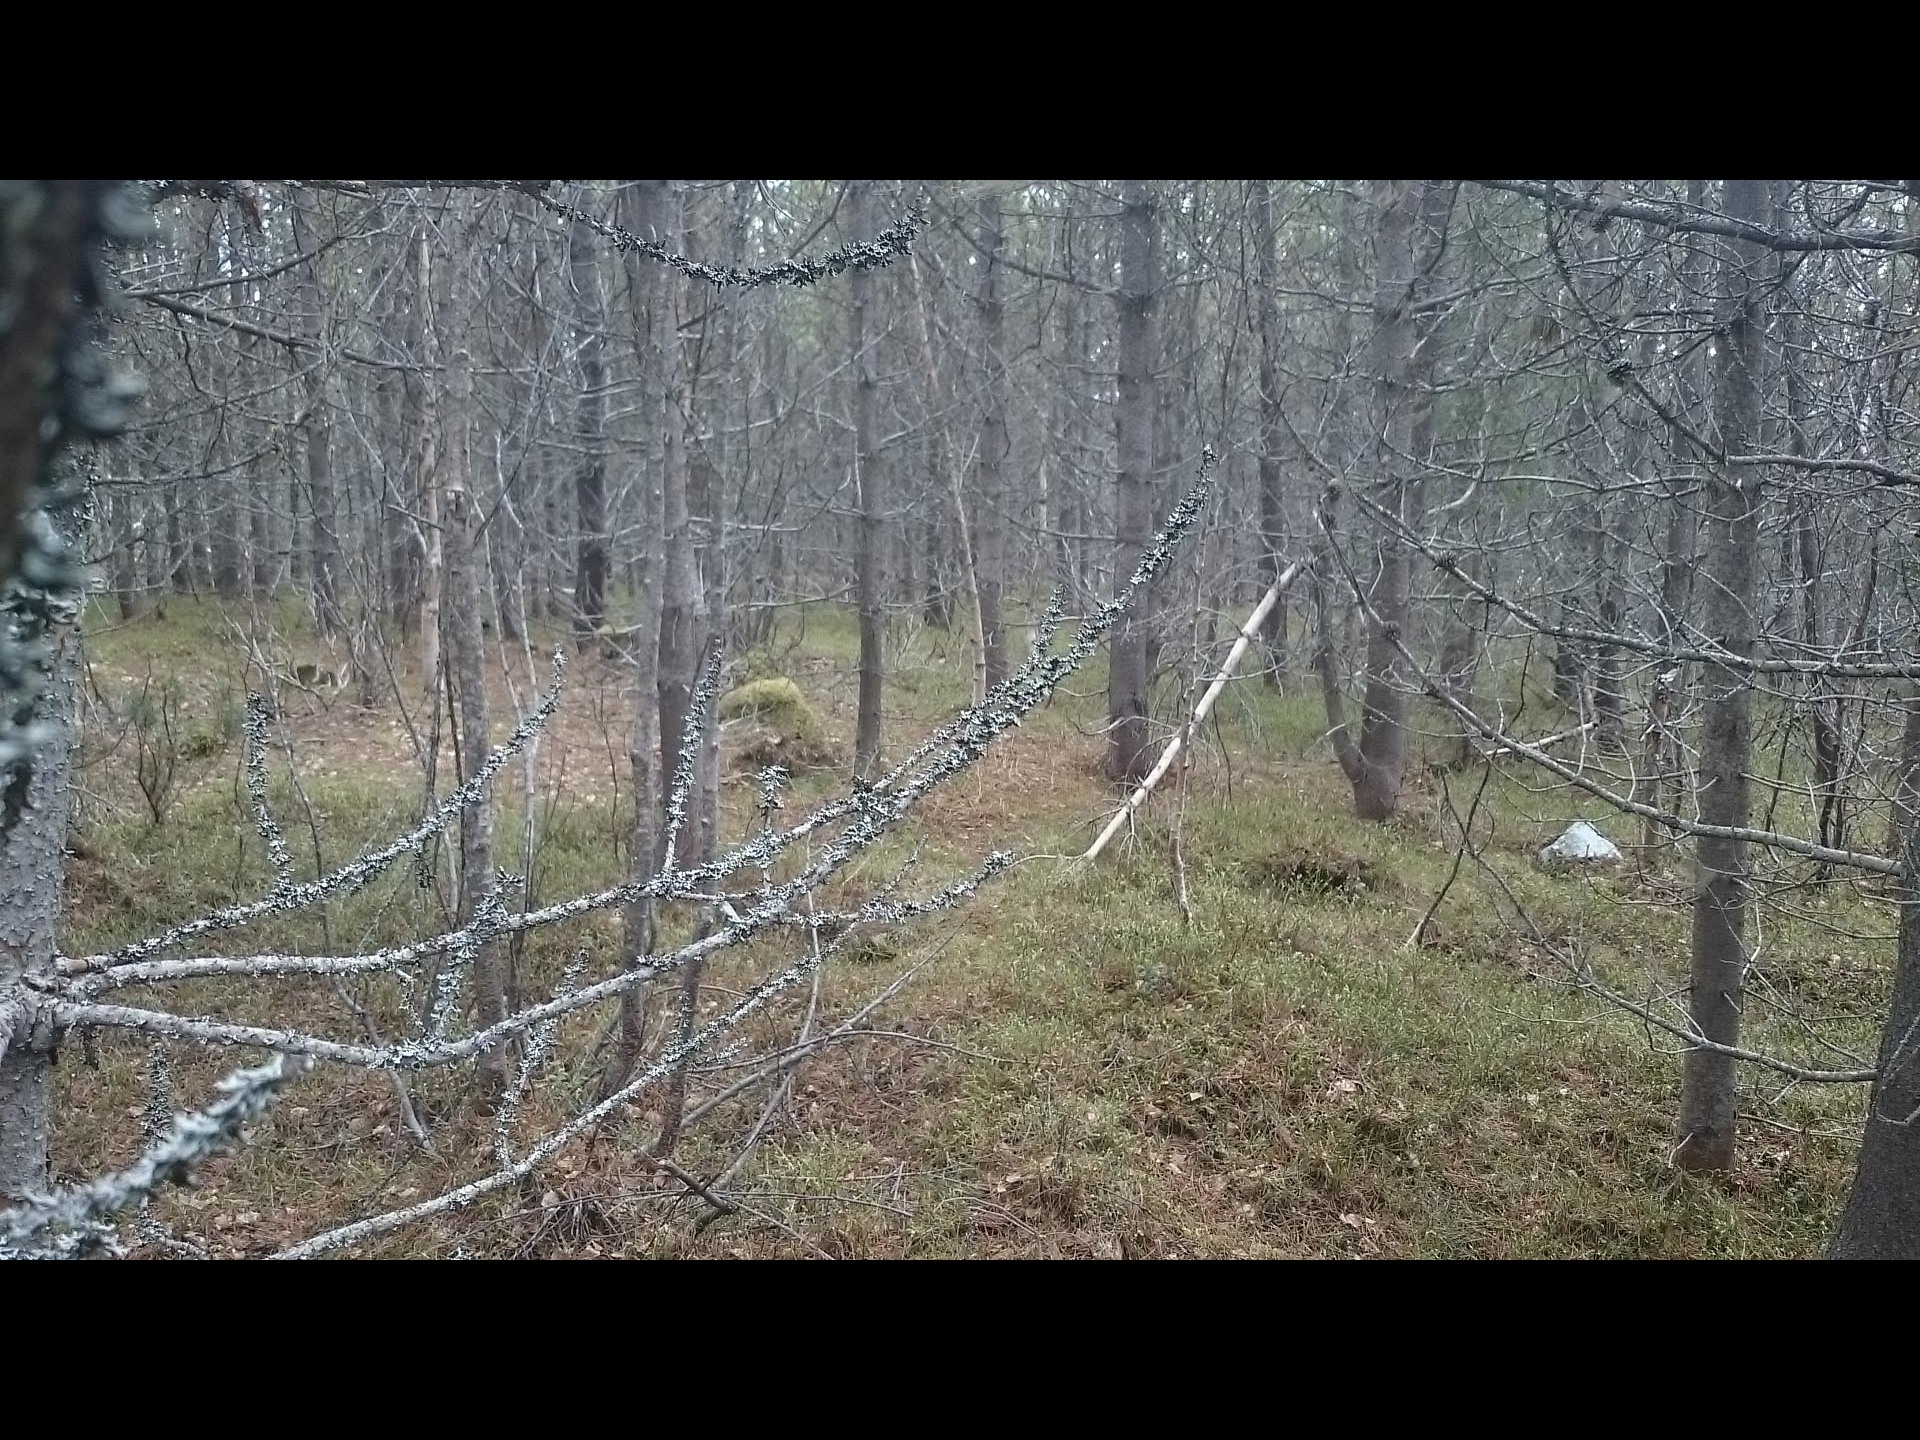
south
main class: Woodland
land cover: Pine dominated coniferous woodland
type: exotic forest
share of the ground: > 75 %
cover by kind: coniferous forest trees 90 %, lichens and mosses 10 %
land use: Forestry
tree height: > 5 m
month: June
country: SE
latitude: 63.7379
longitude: 13.8080
